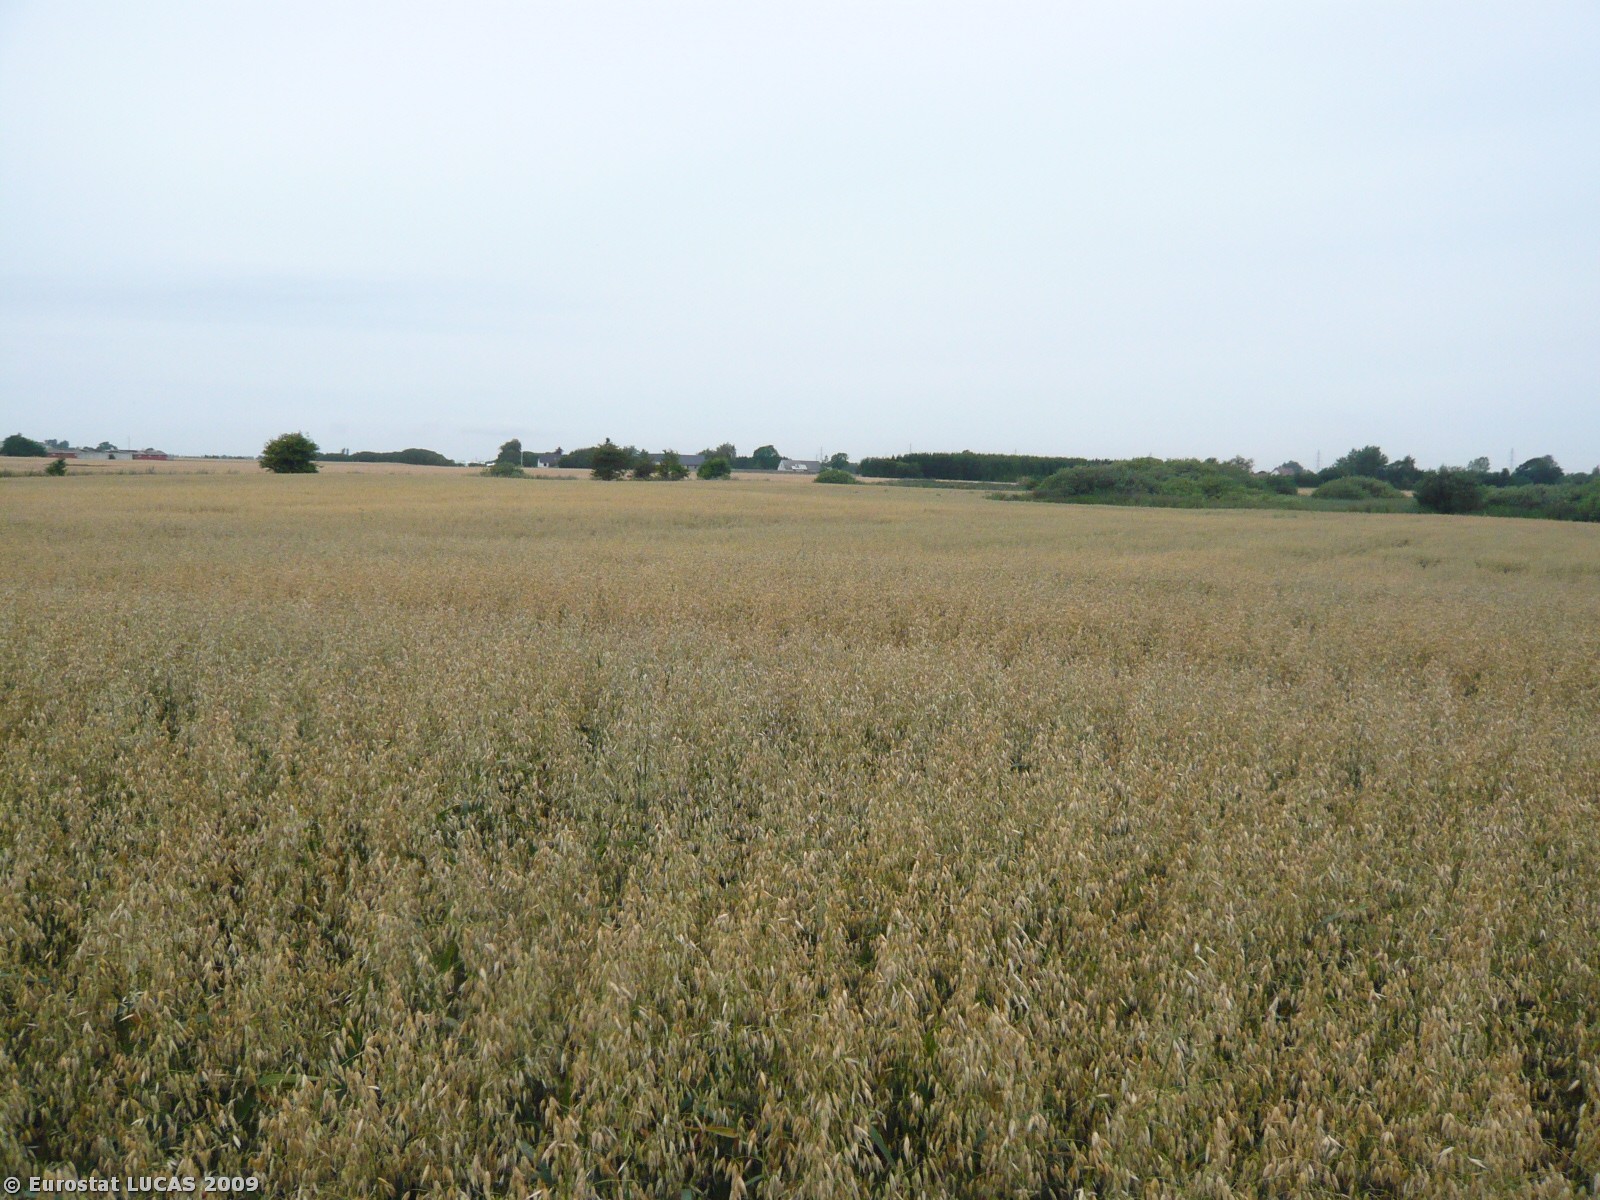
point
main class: Cropland
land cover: Oats
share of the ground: > 75 %
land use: Agriculture (excluding fallow land and kitchen gardens)
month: July
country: DK
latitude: 55.7377
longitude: 12.1801
